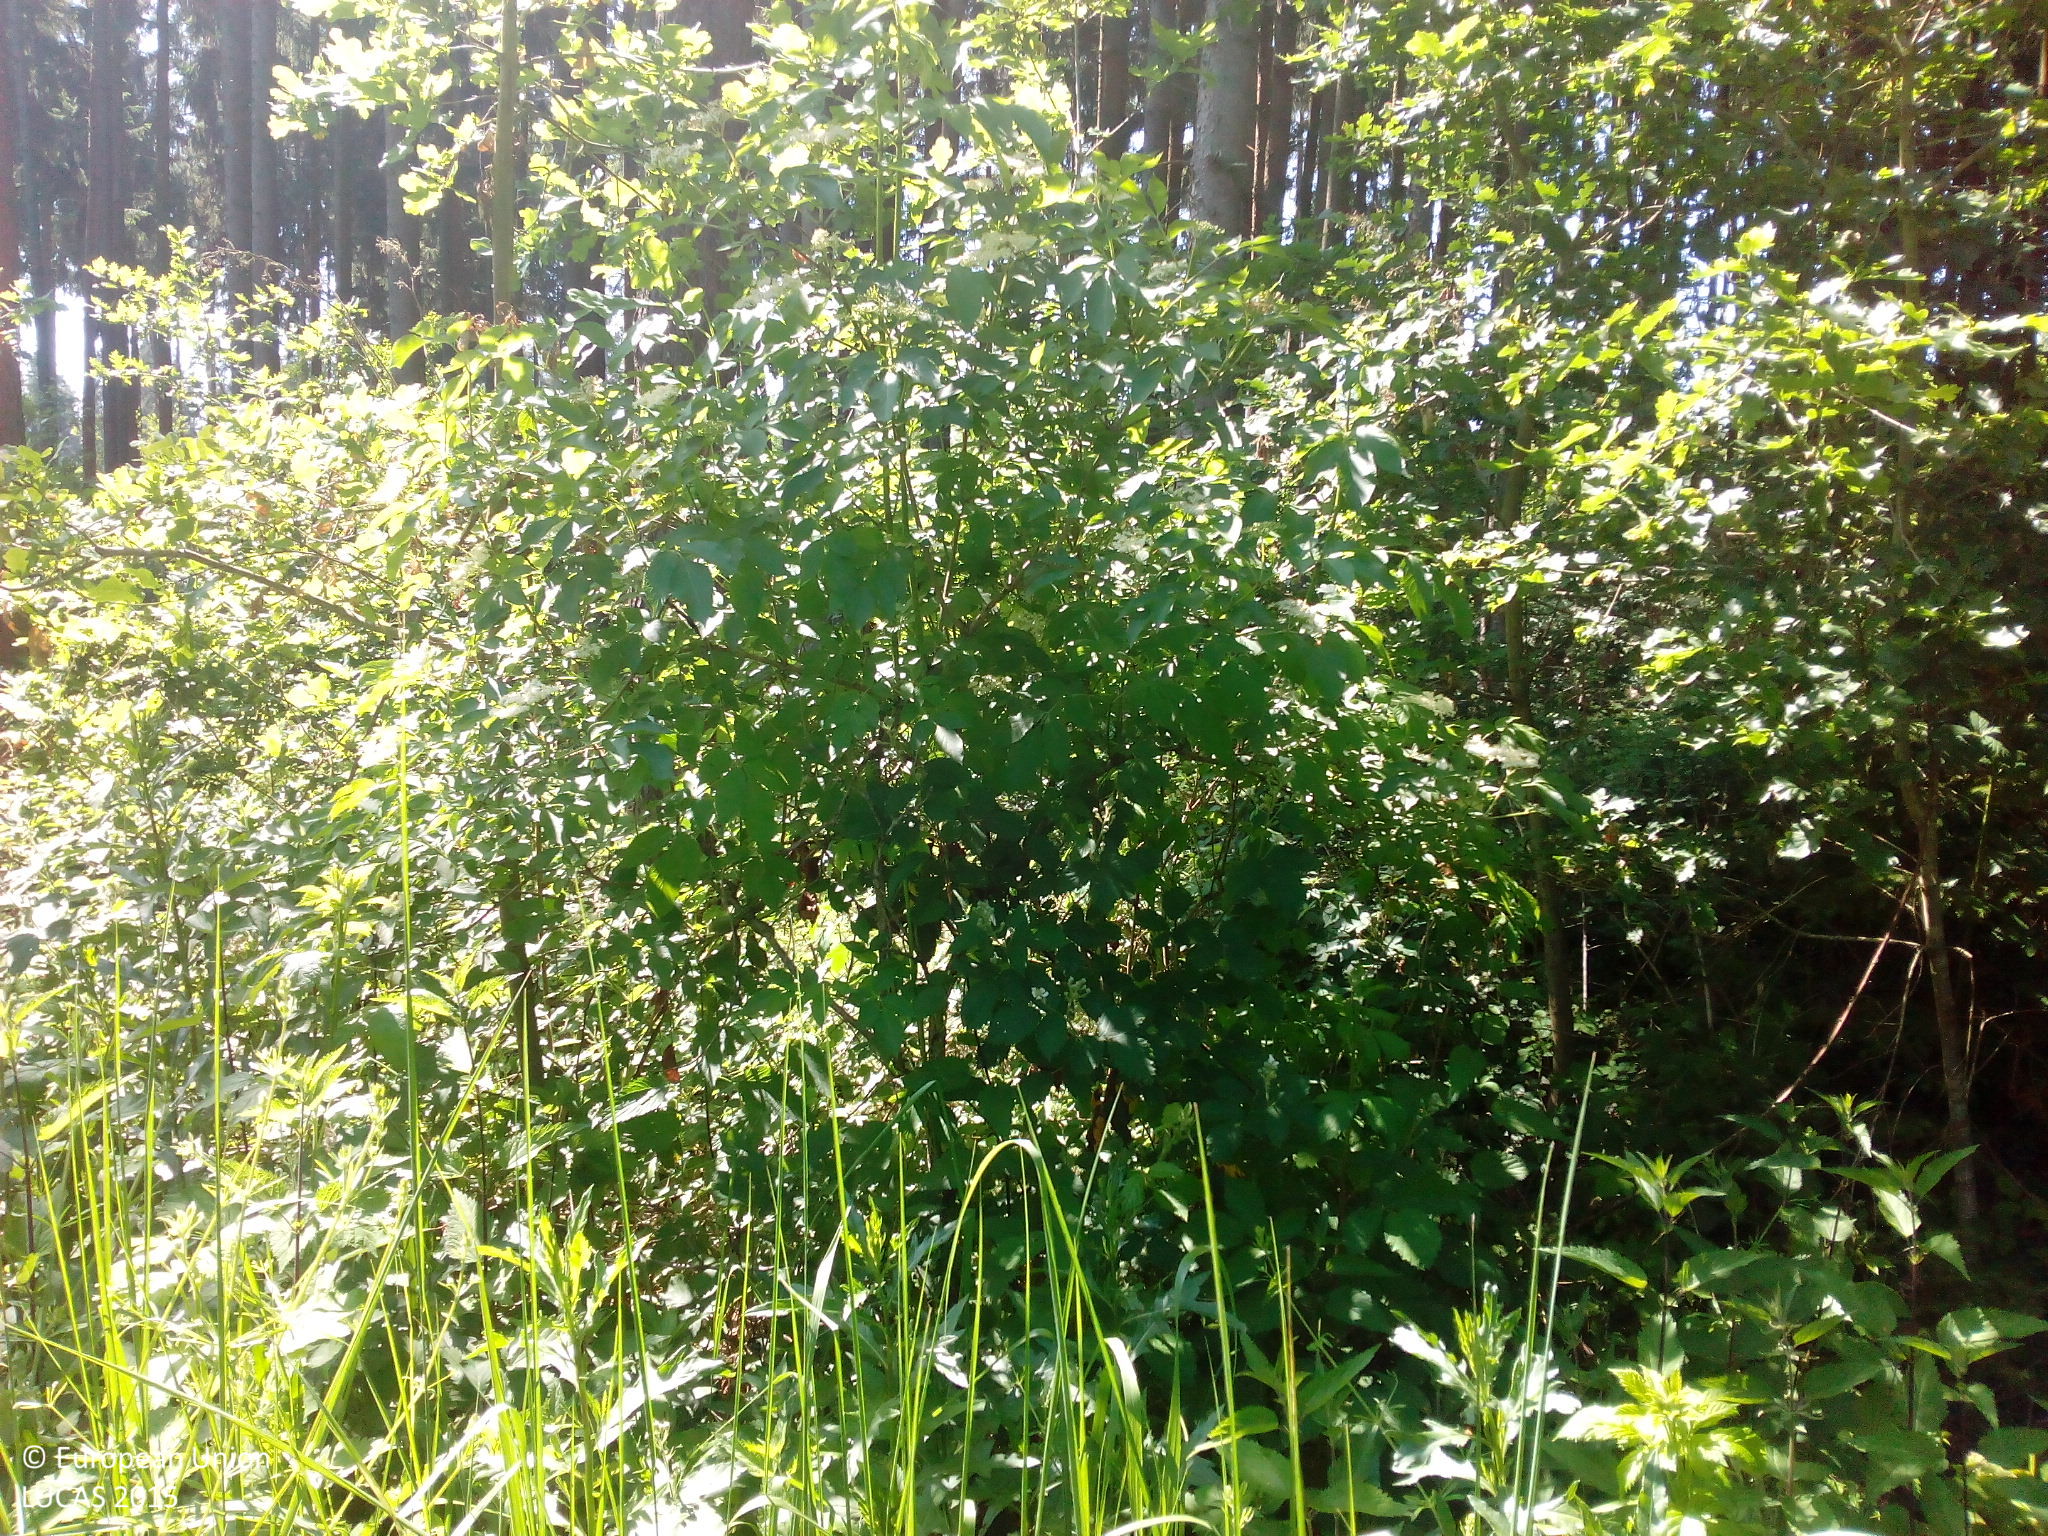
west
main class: Woodland
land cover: Spruce dominated mixed woodland
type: hemiboreal forest and nemoral coniferous forest and mixed broadleaved-coniferous forest
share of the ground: 50 - 75 %
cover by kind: coniferous forest trees 35 %, herbaceous plants 35 %, broadleaved forest trees 20 %, shrubs 10 %
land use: Forestry
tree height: > 5 m
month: June
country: DE
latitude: 48.7913
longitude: 12.4086
